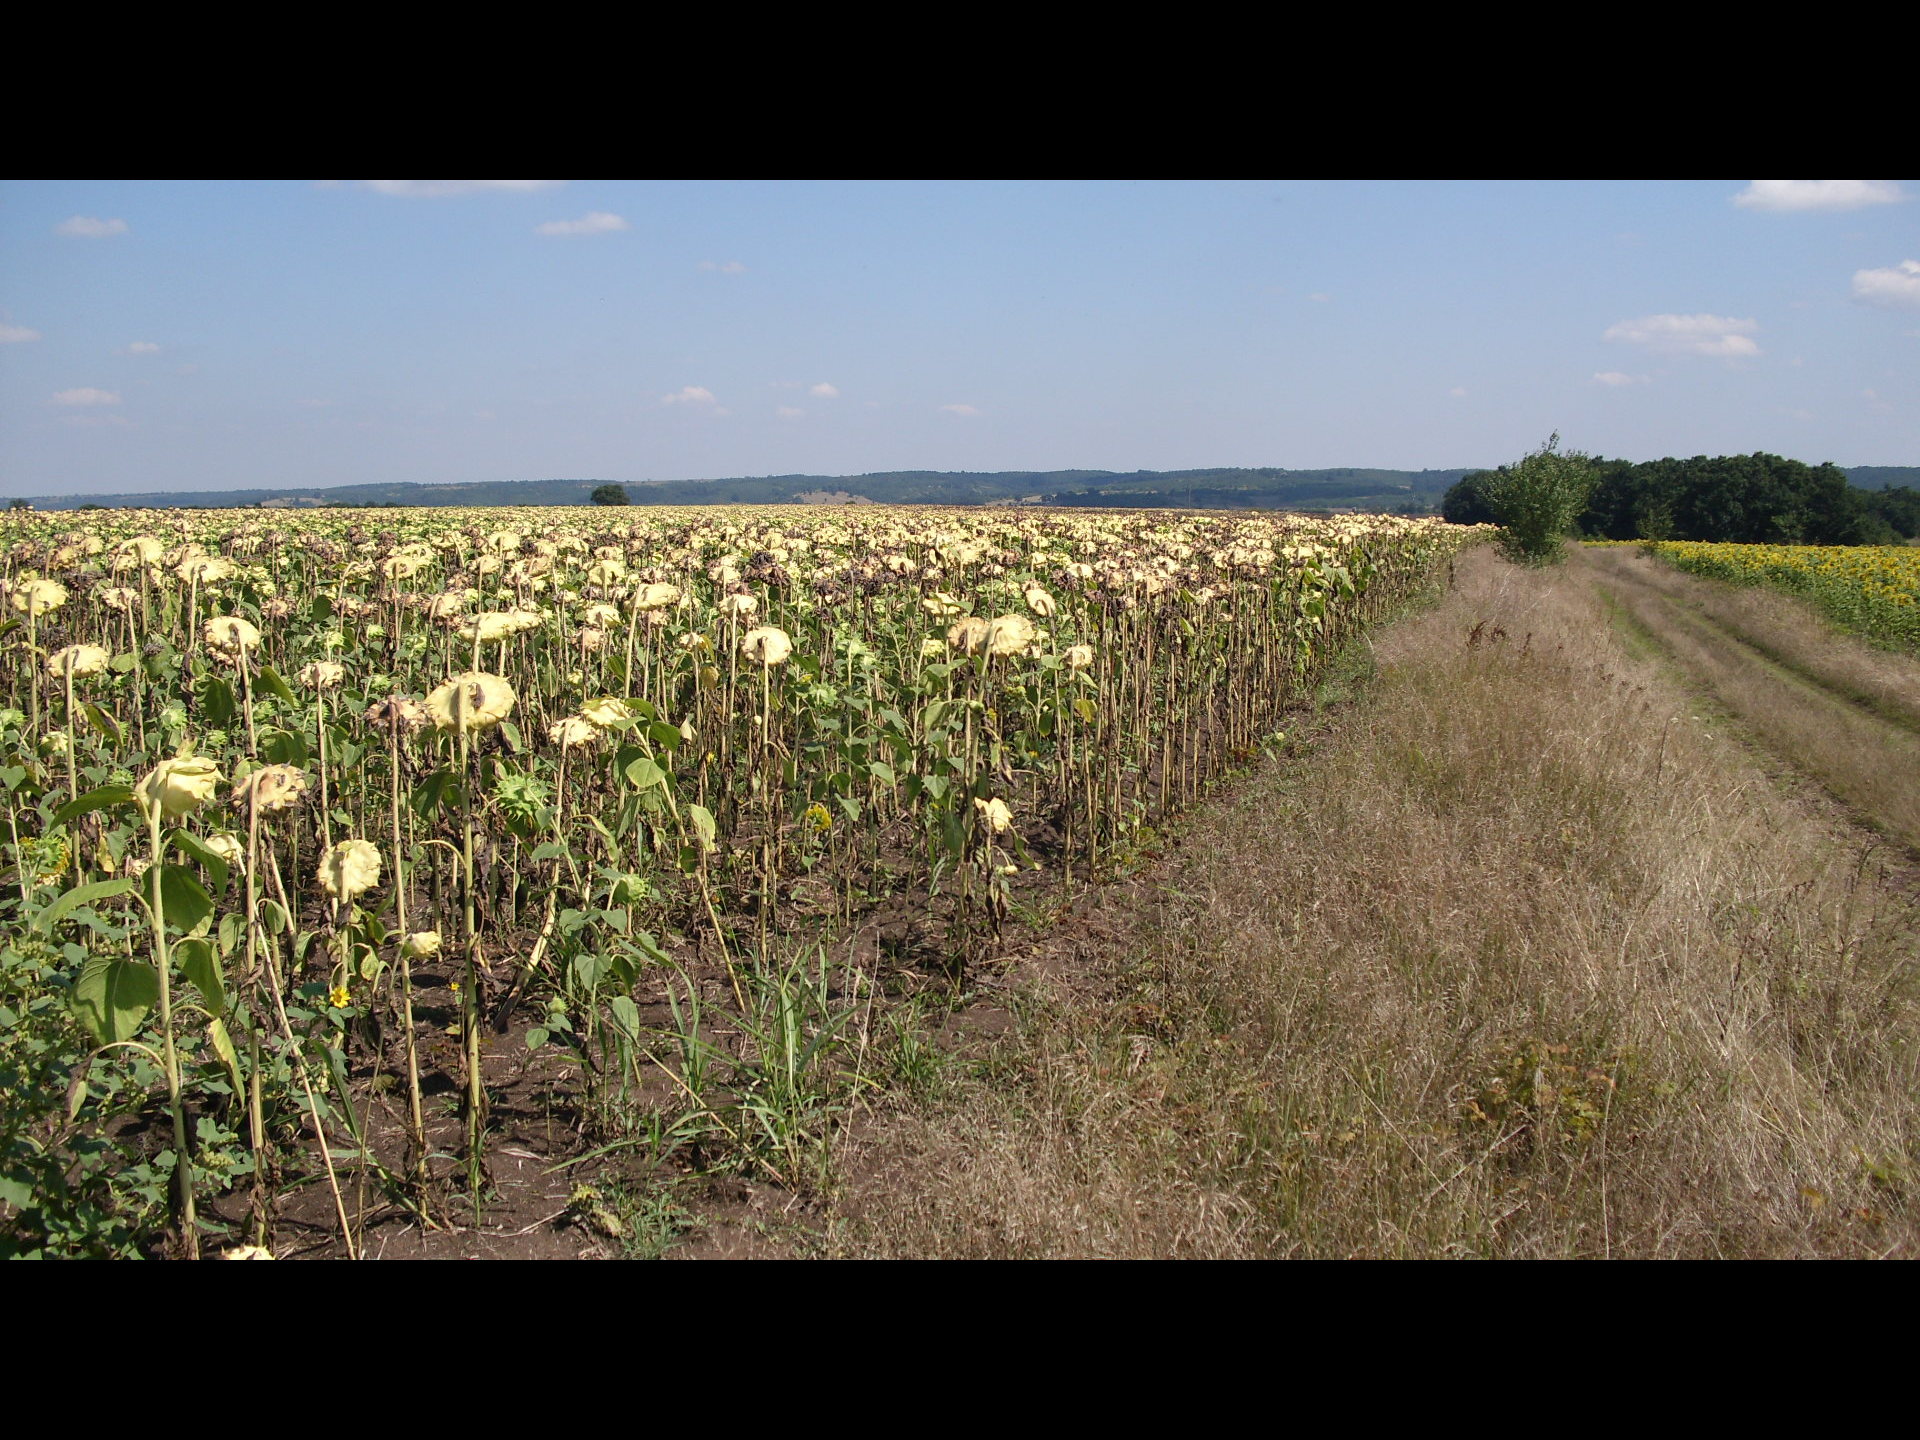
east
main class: Cropland
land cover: Sunflower
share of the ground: > 75 %
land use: Agriculture (excluding fallow land and kitchen gardens)
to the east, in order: Grass margins; Sunflower
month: August
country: BG
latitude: 43.6216
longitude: 22.9881
